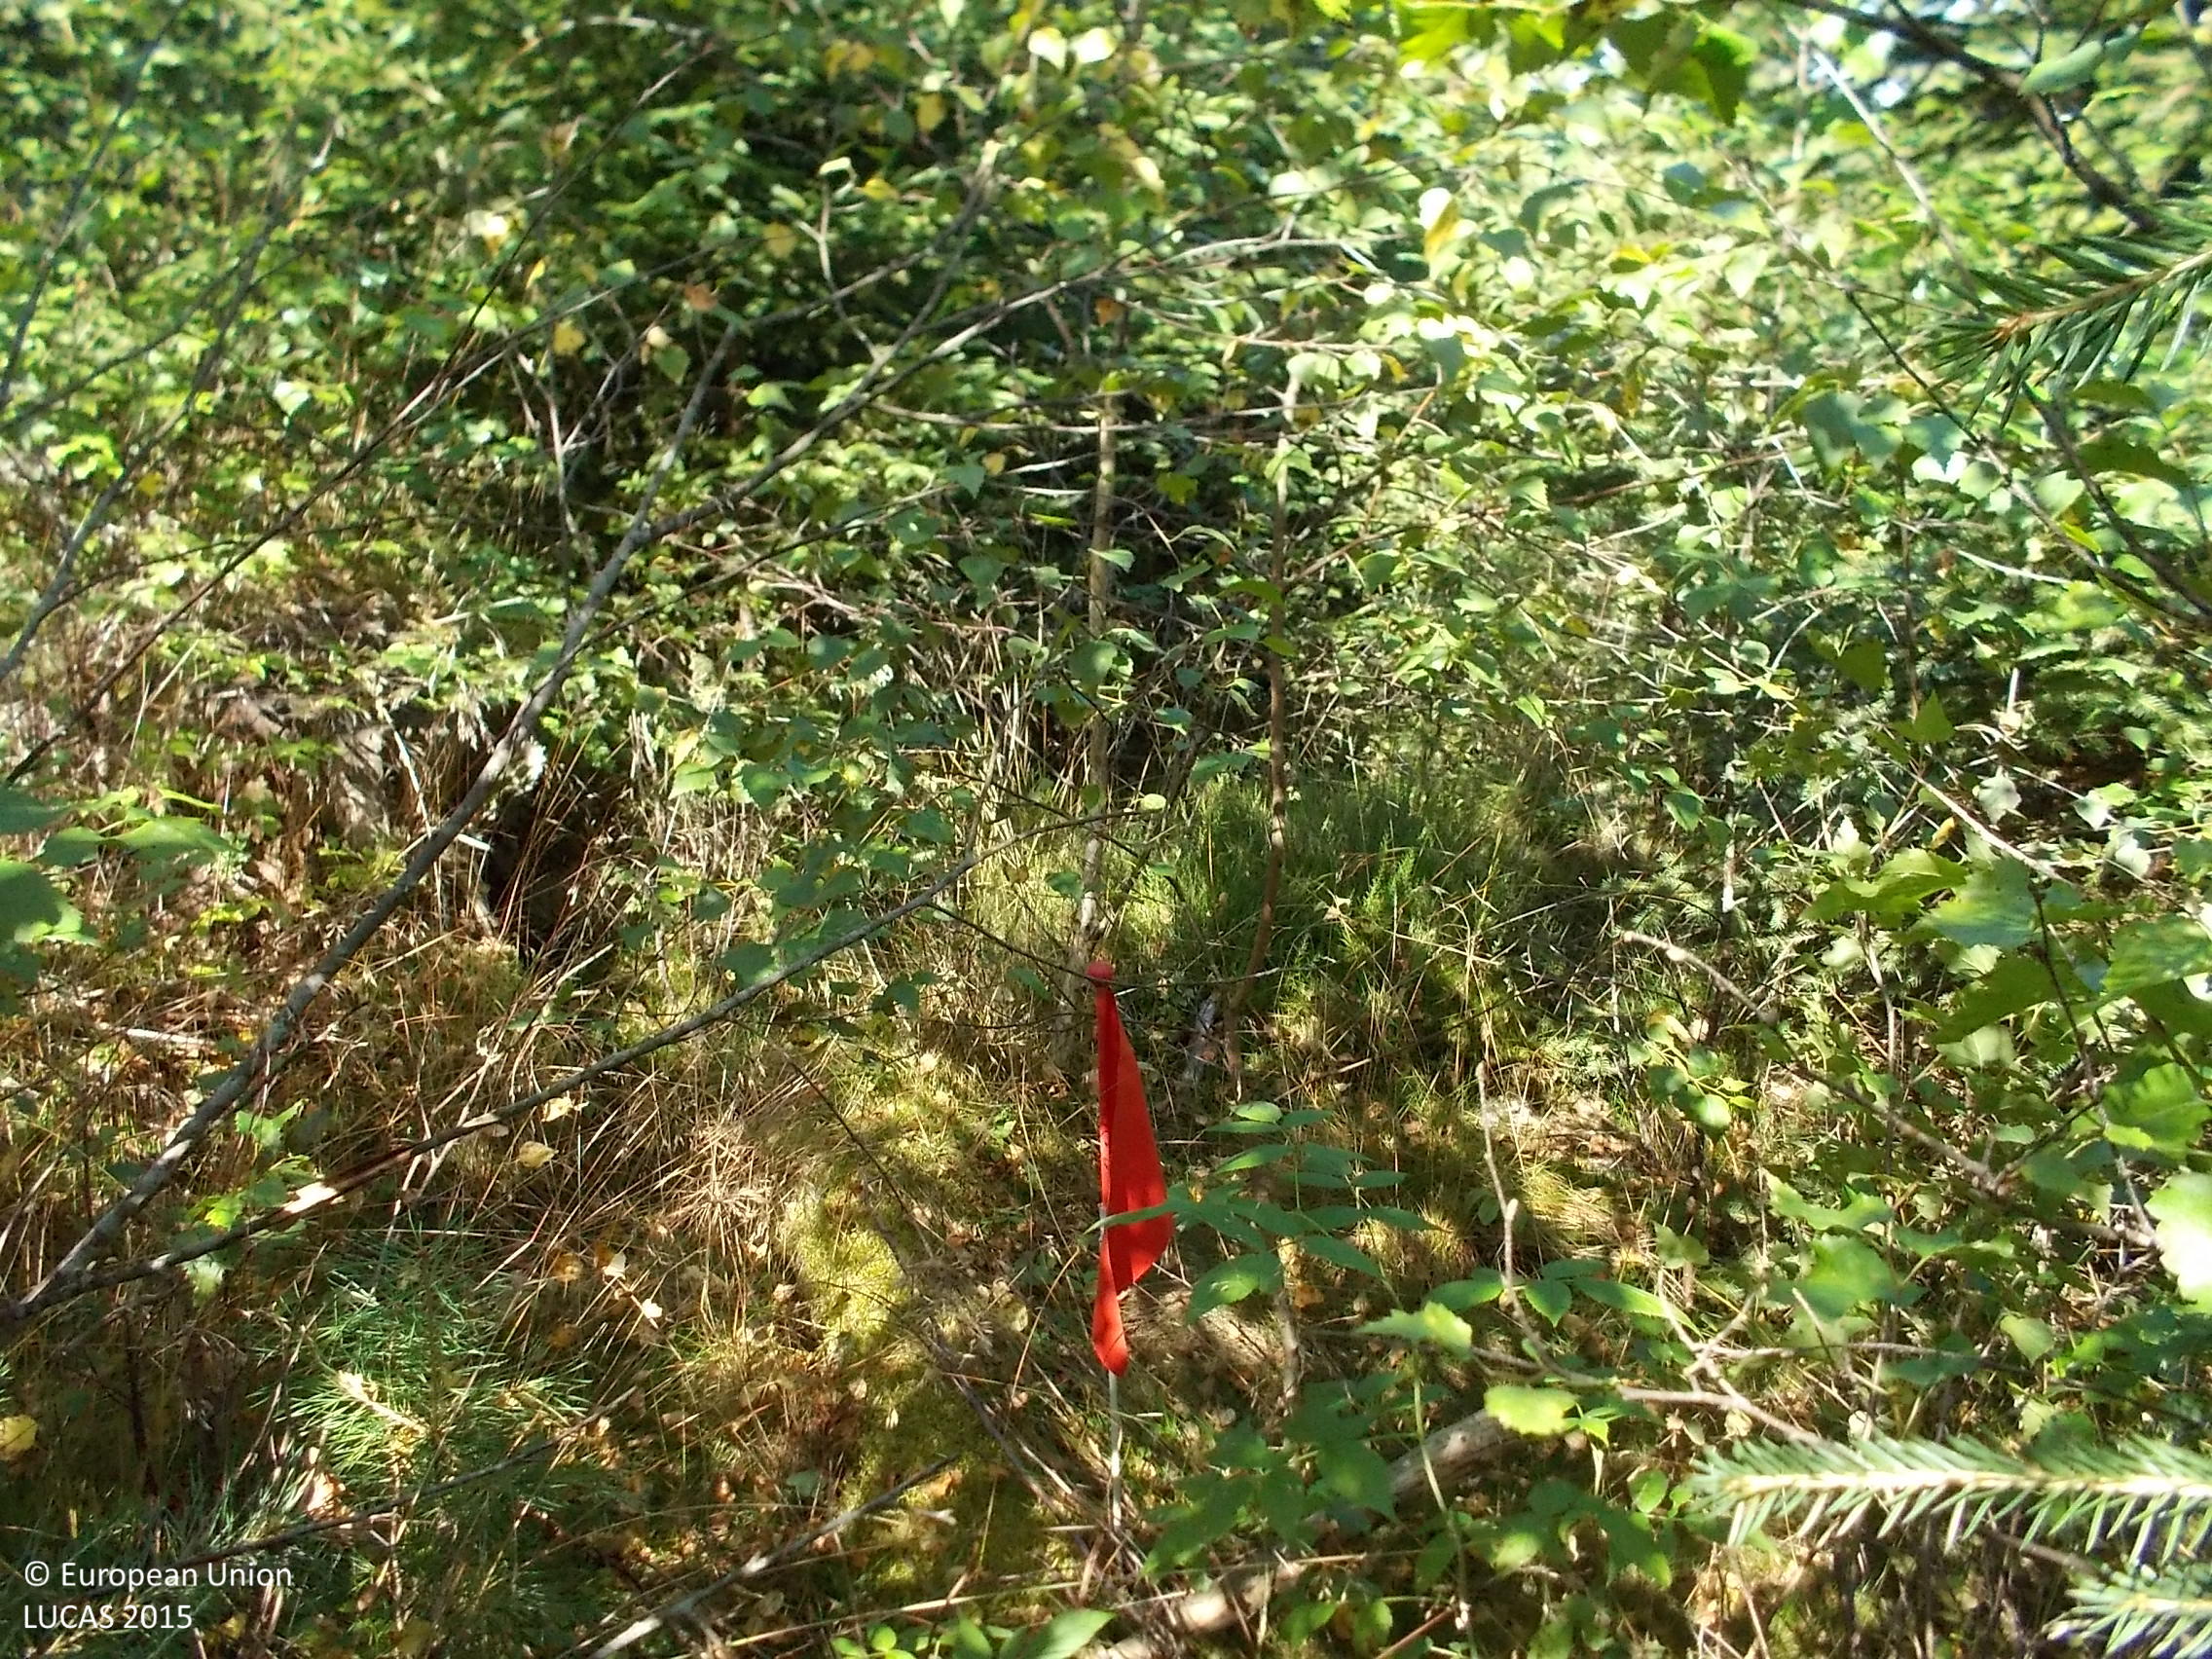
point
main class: Woodland
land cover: Spruce dominated mixed woodland
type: boreal forest
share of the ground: > 75 %
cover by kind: coniferous forest trees 45 %, broadleaved forest trees 40 %, herbaceous plants 10 %, lichens and mosses 5 %
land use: Forestry
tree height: < 5 m
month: August
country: SE
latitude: 57.4612
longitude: 13.2129
